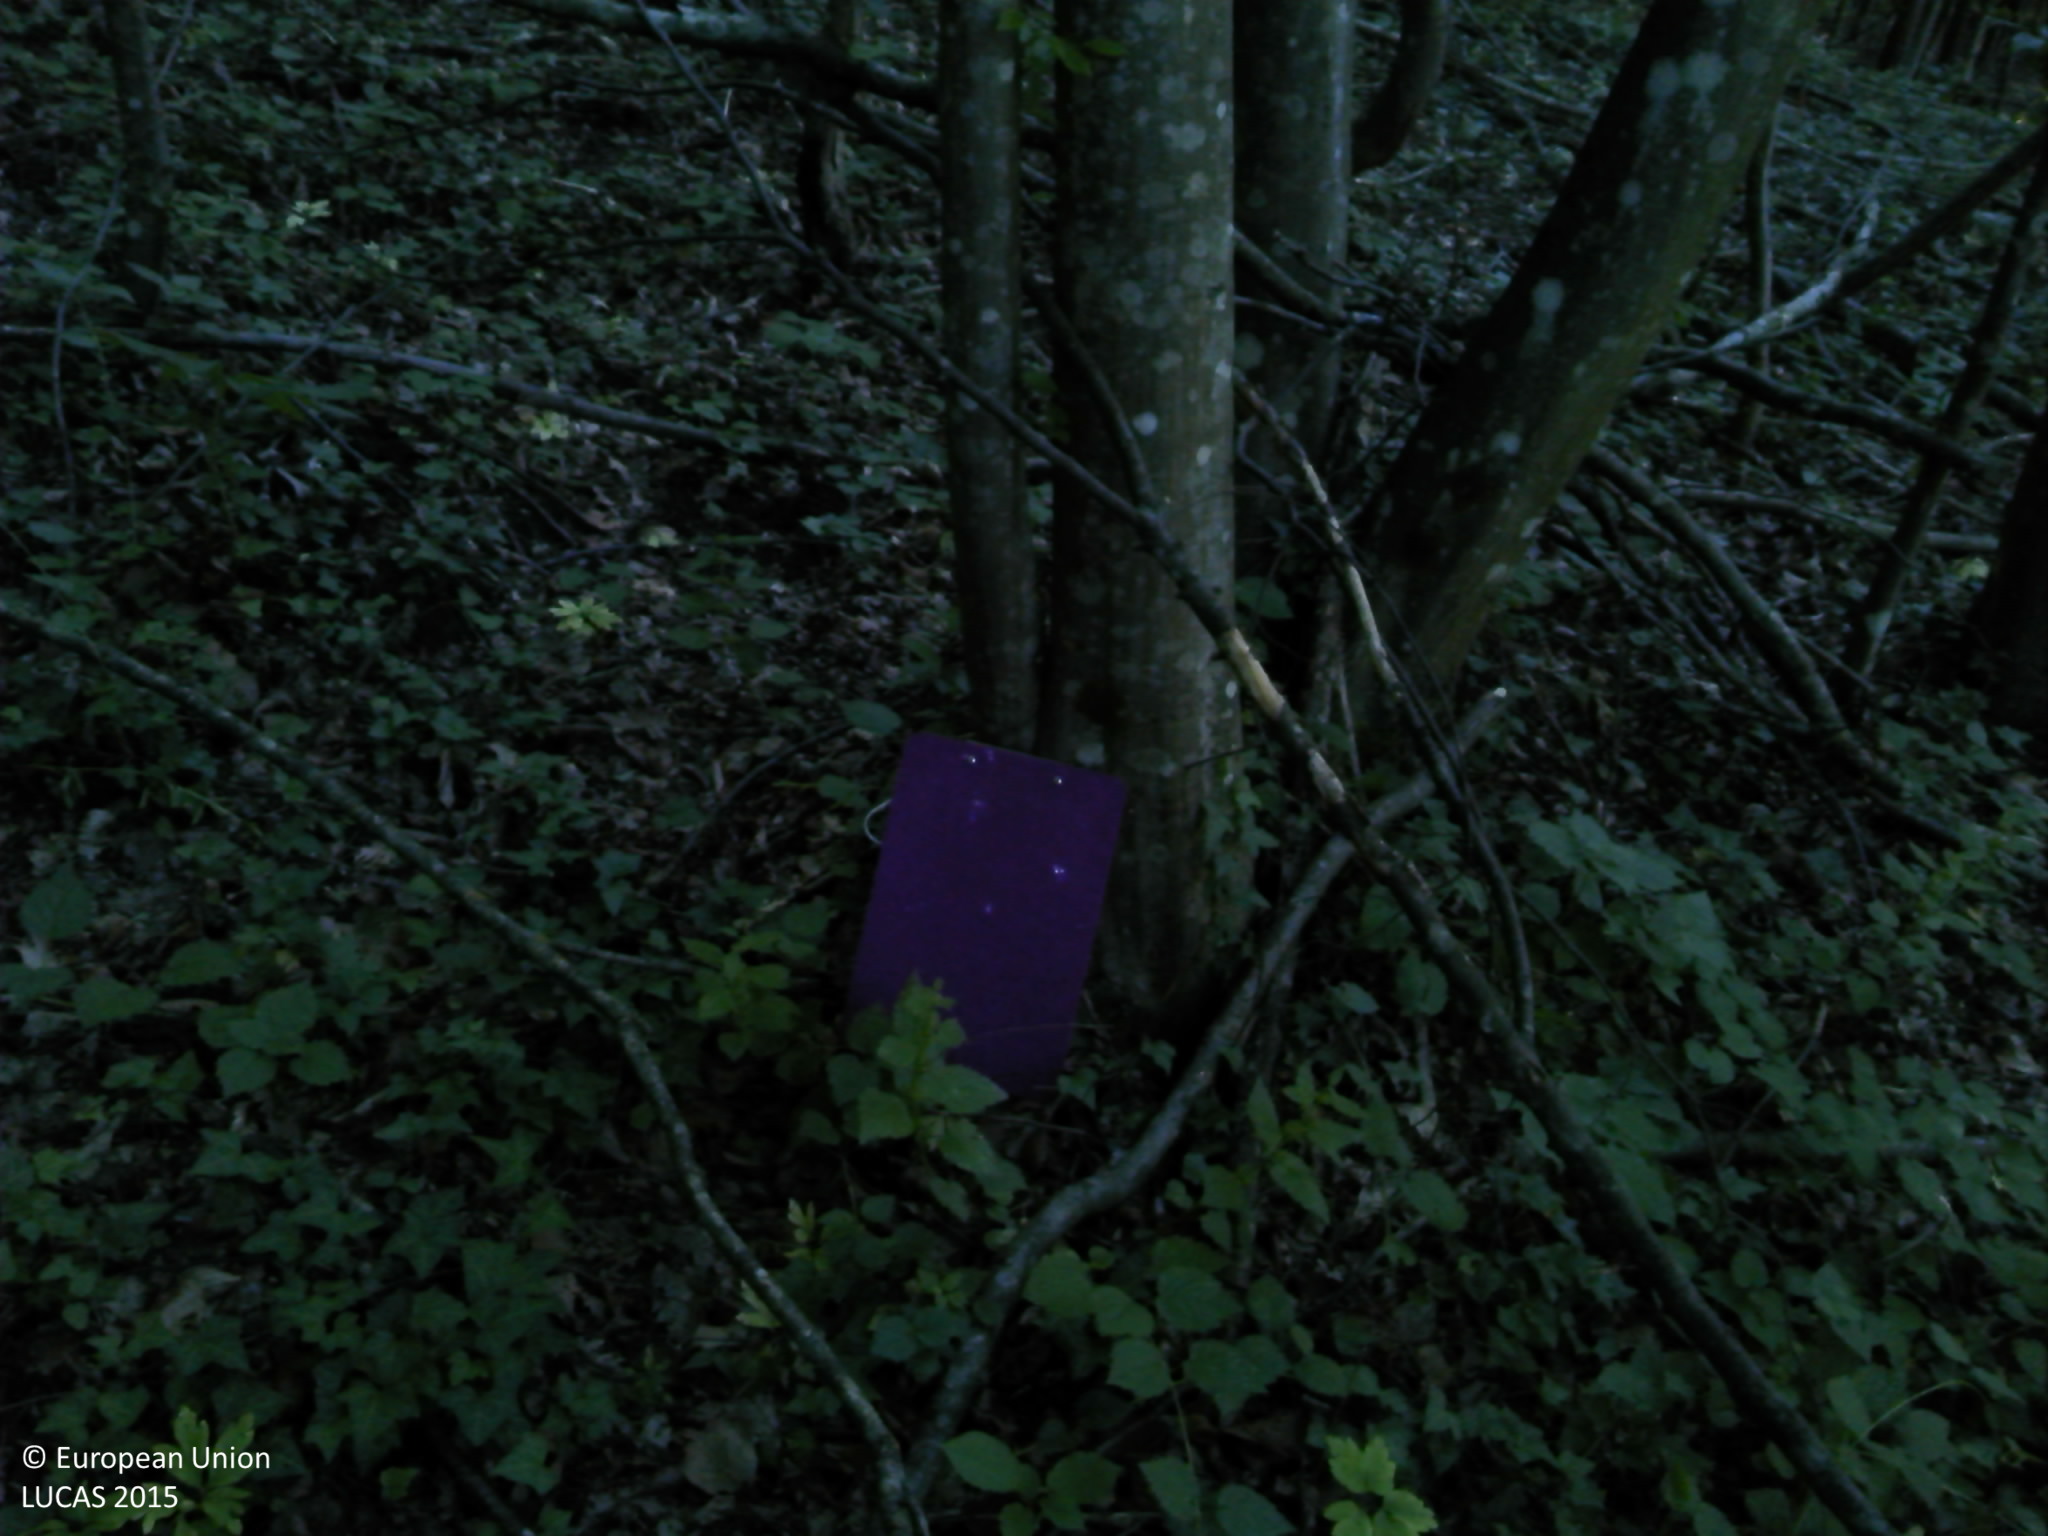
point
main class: Woodland
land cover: Broadleaved woodland
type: beech forest
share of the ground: > 75 %
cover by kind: broadleaved forest trees 100 %
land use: Forestry
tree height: < 5 m
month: May
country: HR
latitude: 45.3270
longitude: 18.0027
